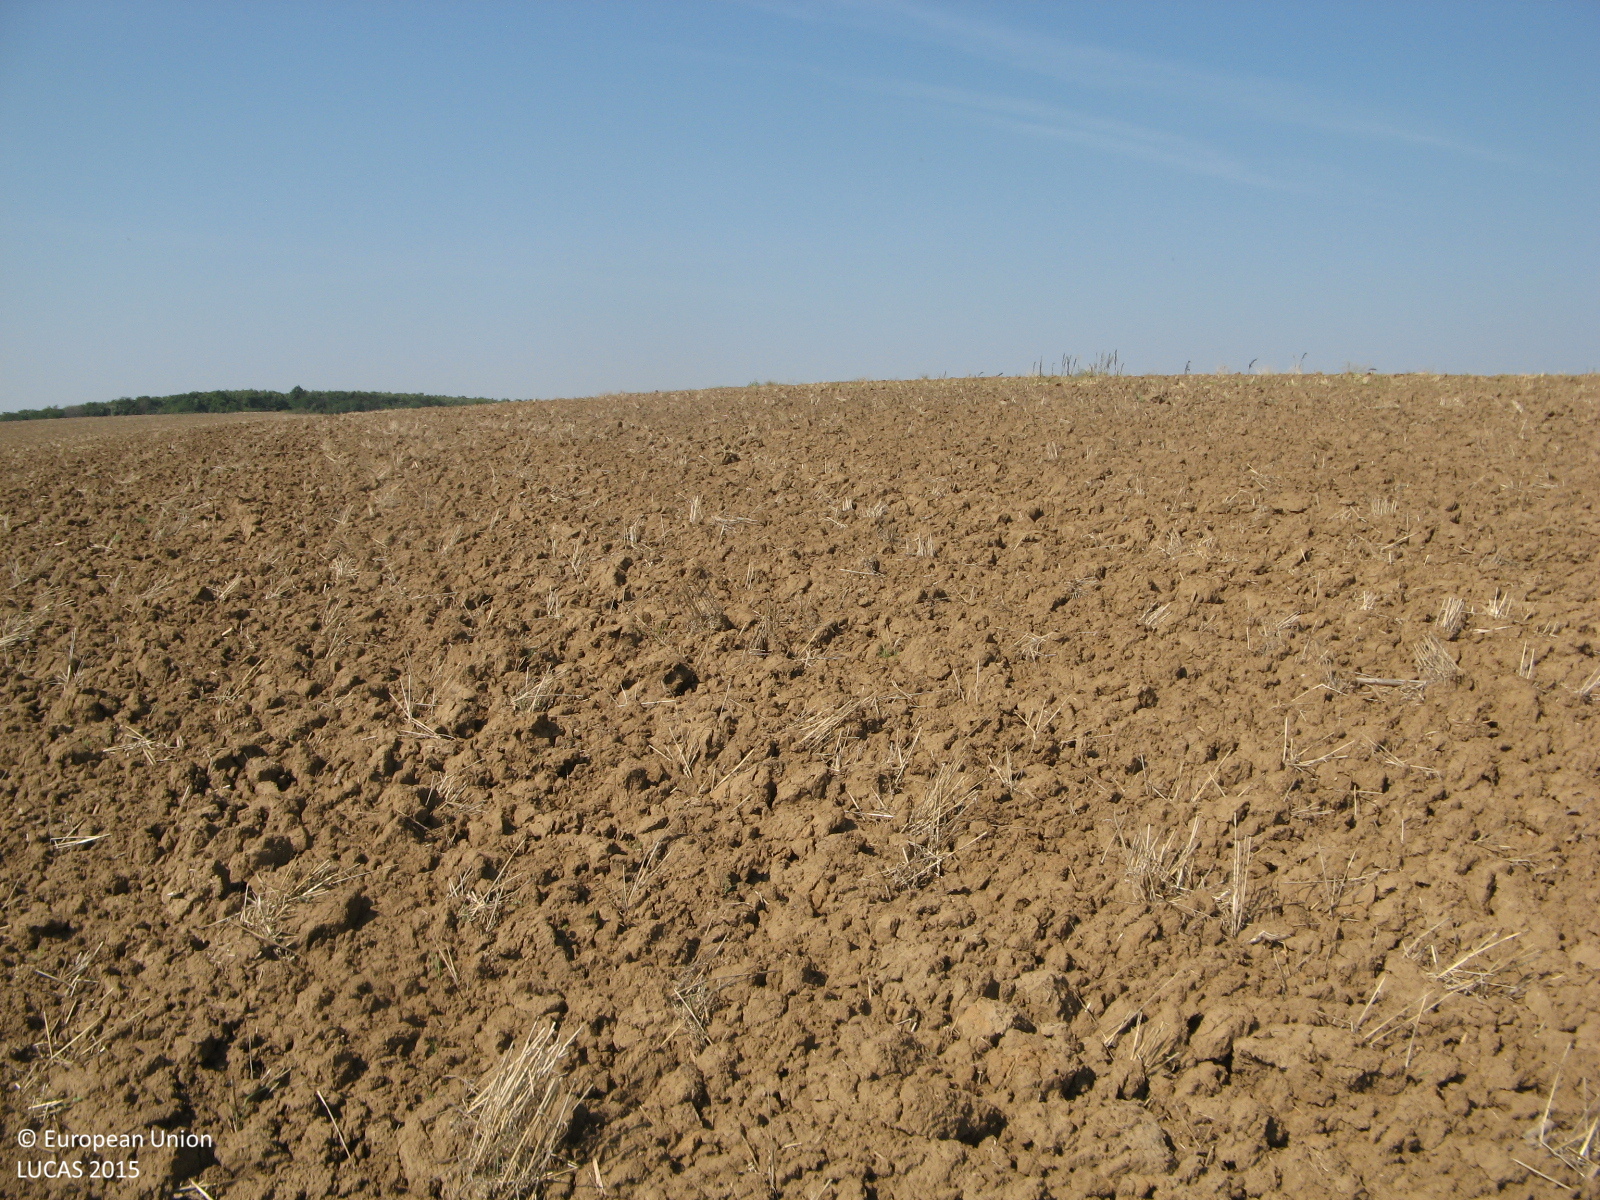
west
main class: Cropland
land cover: Common wheat
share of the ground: < 10 %
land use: Agriculture (excluding fallow land and kitchen gardens)
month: August
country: BG
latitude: 43.4680
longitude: 25.8744
